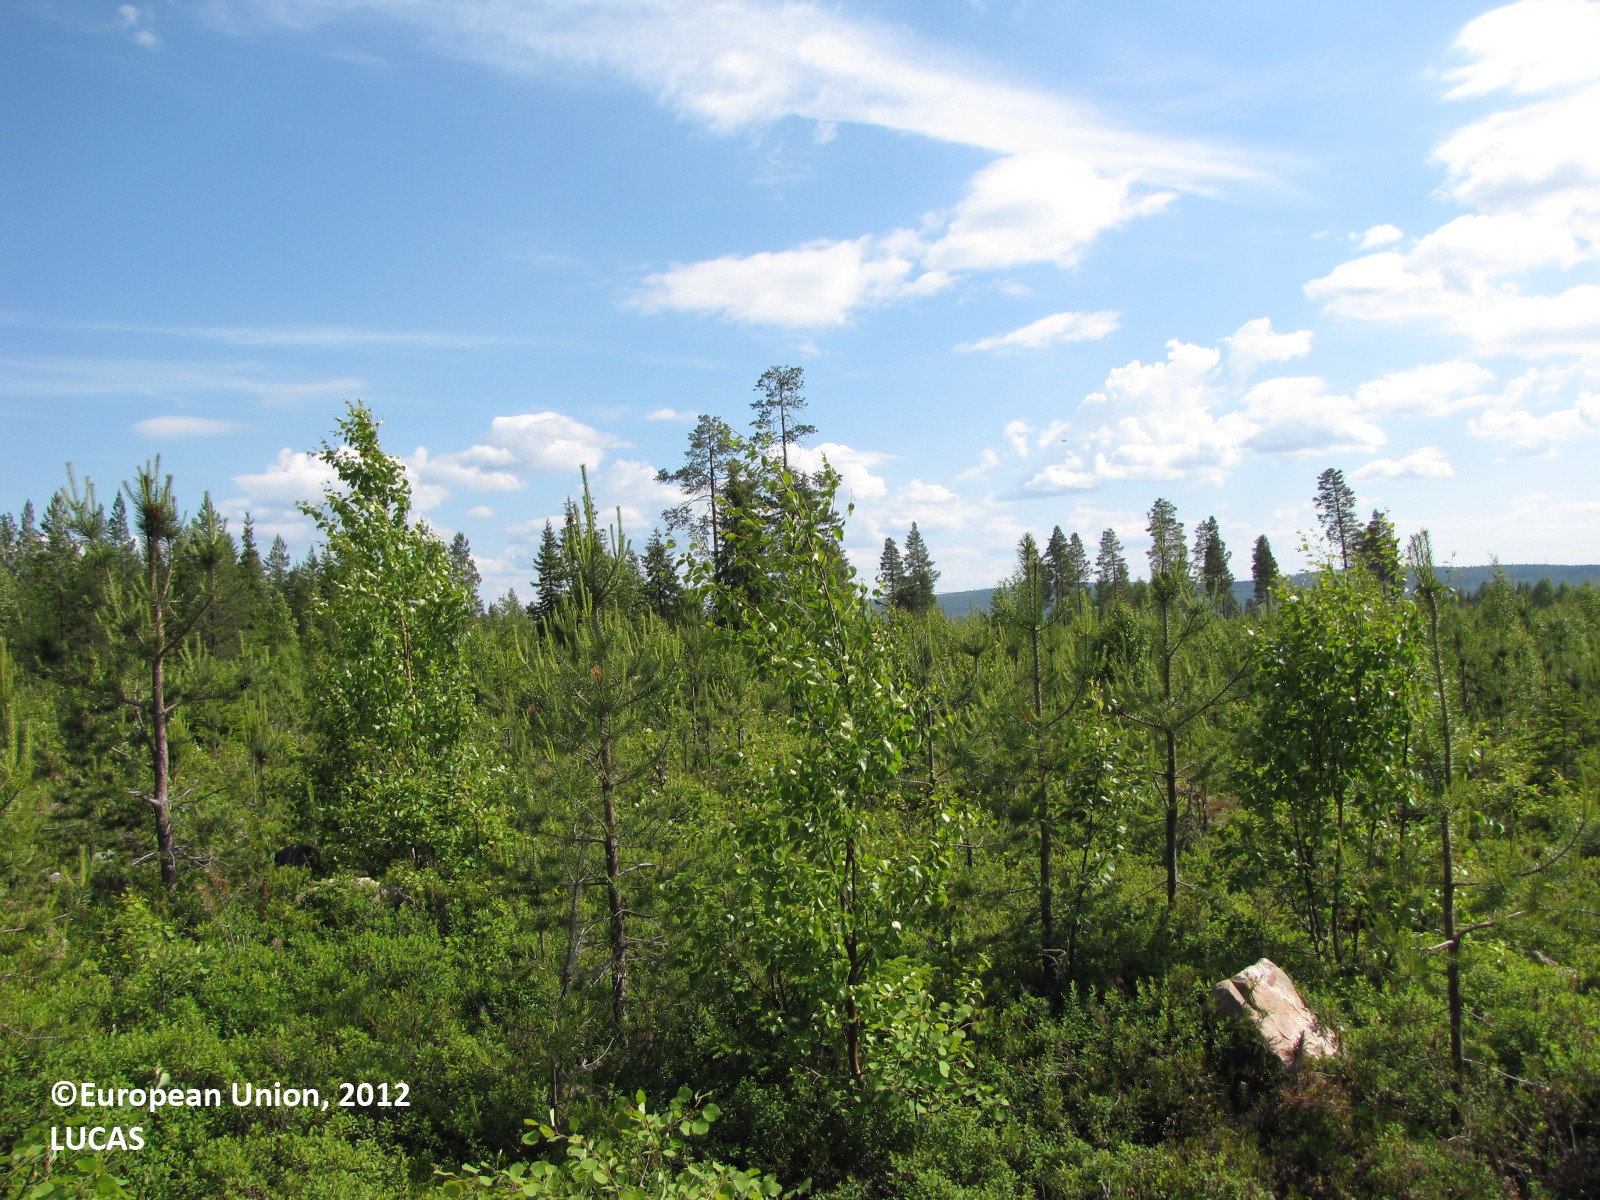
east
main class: Woodland
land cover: Other mixed woodland
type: boreal forest
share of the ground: 25 - 50 %
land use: Forestry
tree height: < 5 m
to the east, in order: Other mixed woodland; Ditches and canals; Other mixed woodland; Ditches and canals; Other mixed woodland; Ditches and canals; Other mixed woodland; Ditches and canals; Other mixed woodland
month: July
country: FI
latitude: 66.2571
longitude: 25.3097
